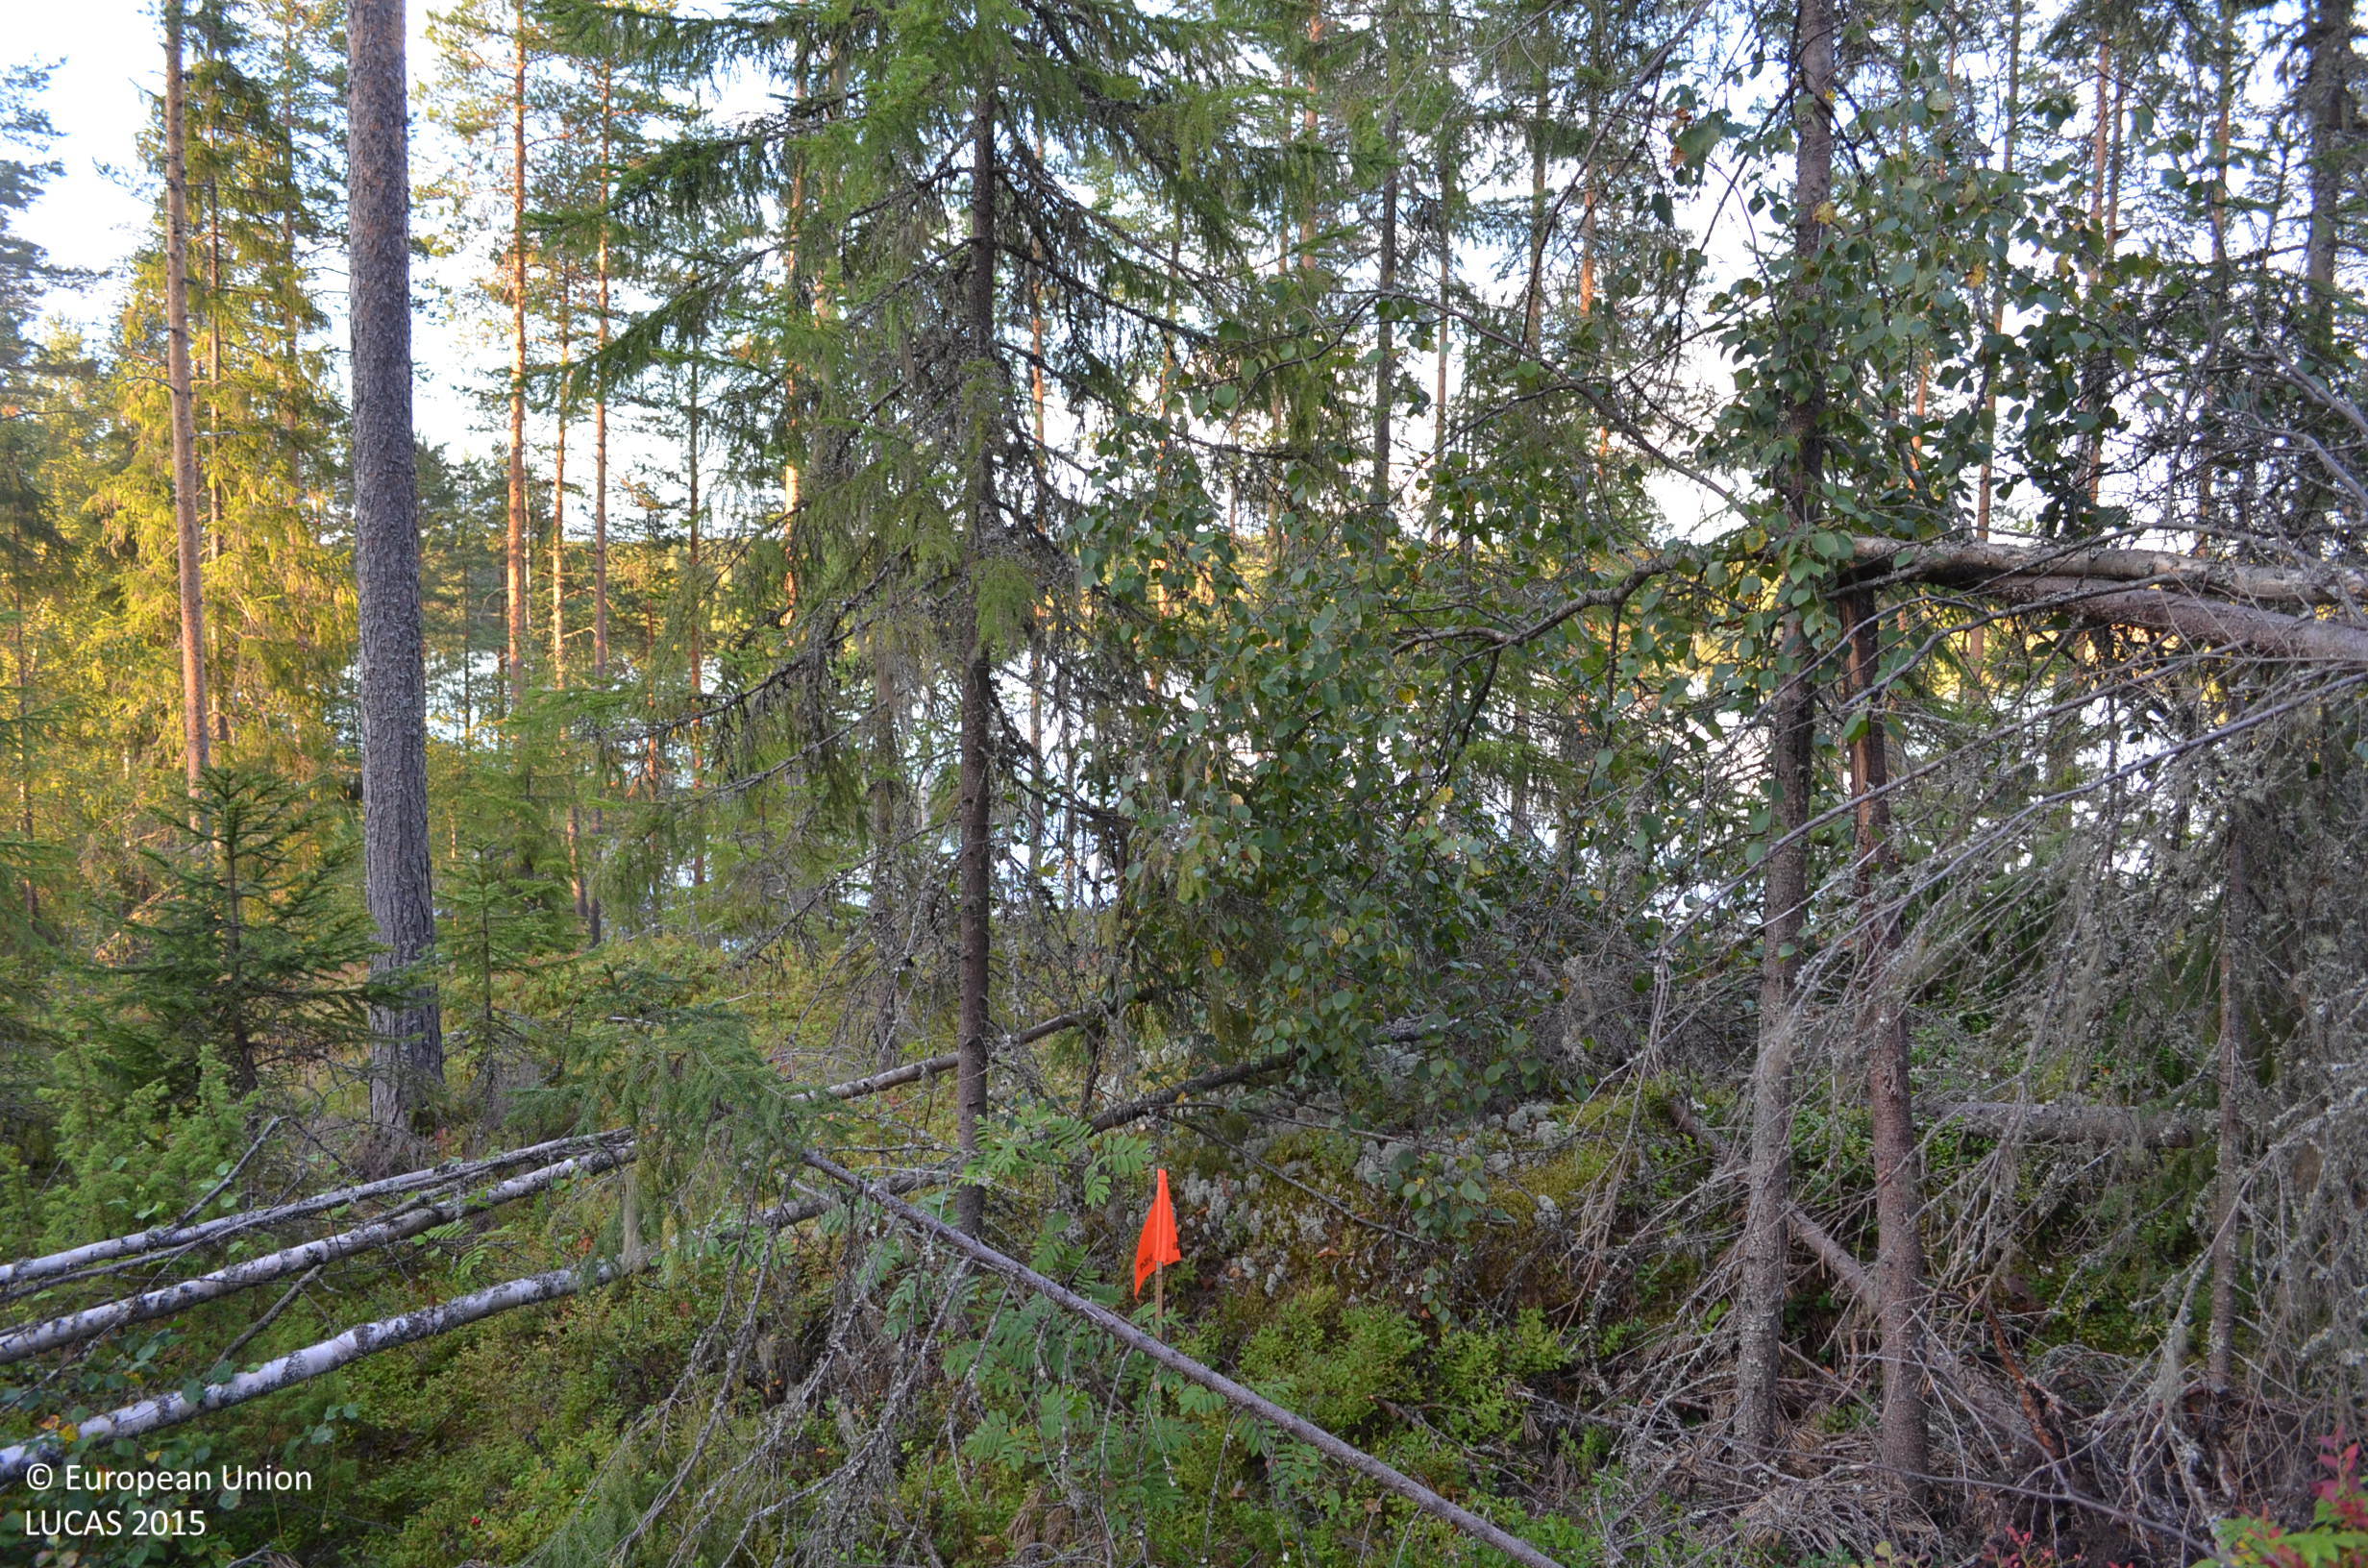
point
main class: Woodland
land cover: Other coniferous woodland
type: boreal forest
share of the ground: 50 - 75 %
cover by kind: coniferous forest trees 50 %, shrubs 30 %, broadleaved forest trees 10 %
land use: Forestry
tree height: > 5 m
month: August
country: FI
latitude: 62.4097
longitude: 23.6415
